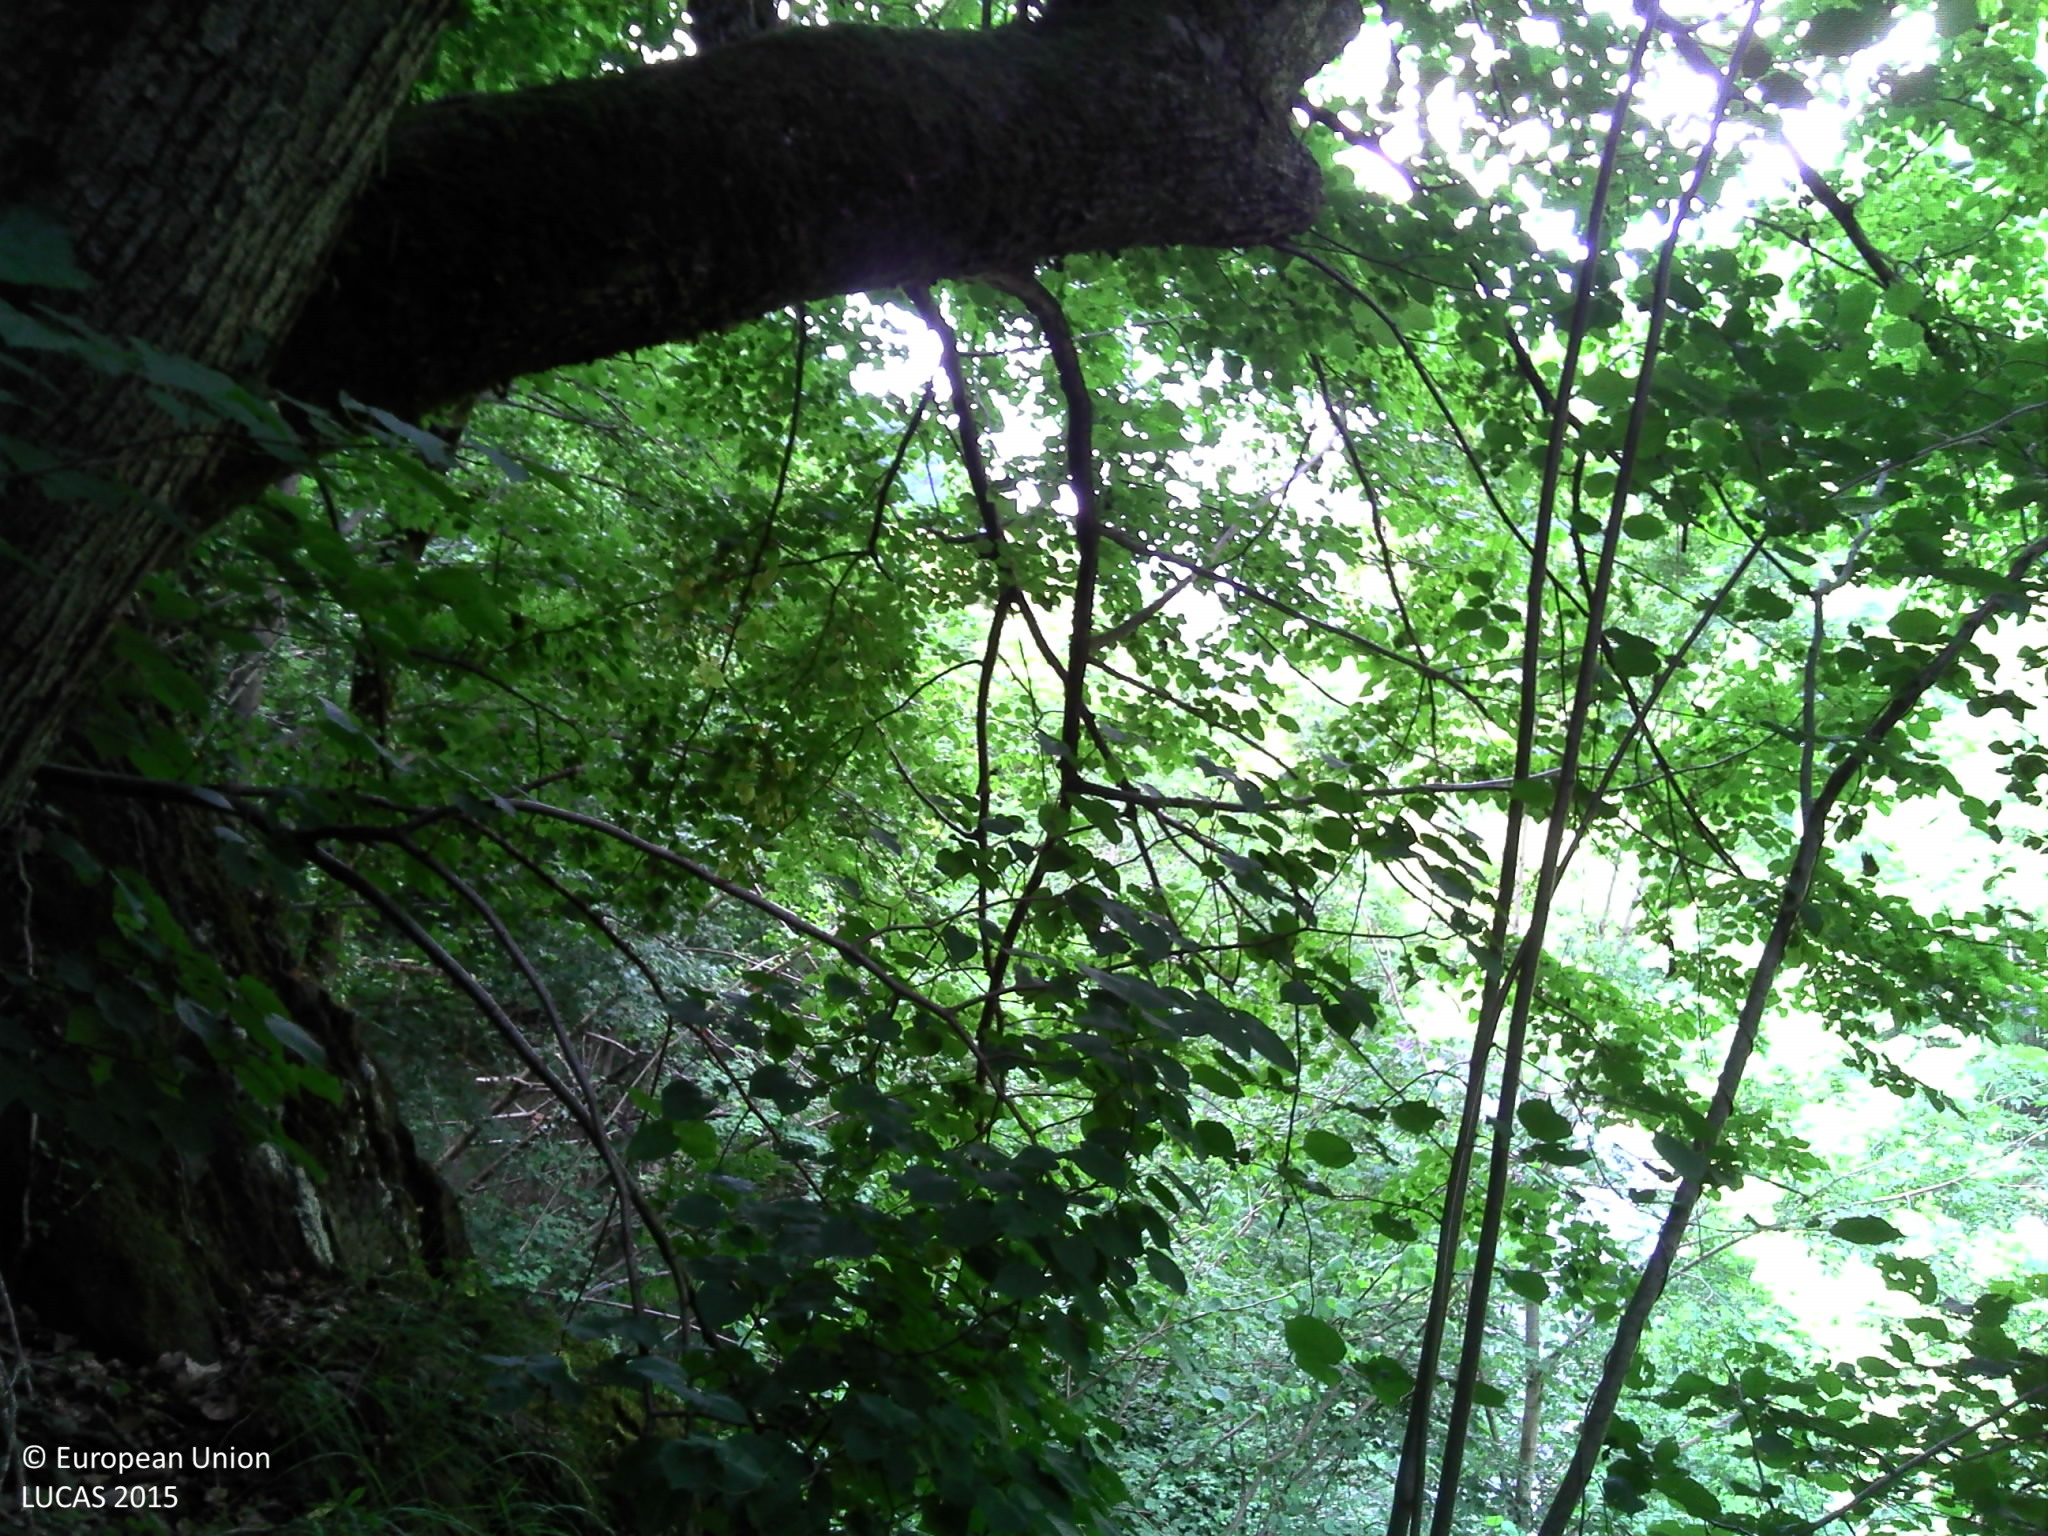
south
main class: Woodland
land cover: Broadleaved woodland
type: mesophytic deciduous forest
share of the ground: > 75 %
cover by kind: broadleaved forest trees 80 %, unconsolidated bare surface 10 %, shrubs 5 %, herbaceous plants 5 %
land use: Semi-natural and natural areas not in use
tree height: > 5 m
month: July
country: FR
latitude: 42.9312
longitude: -0.0863
